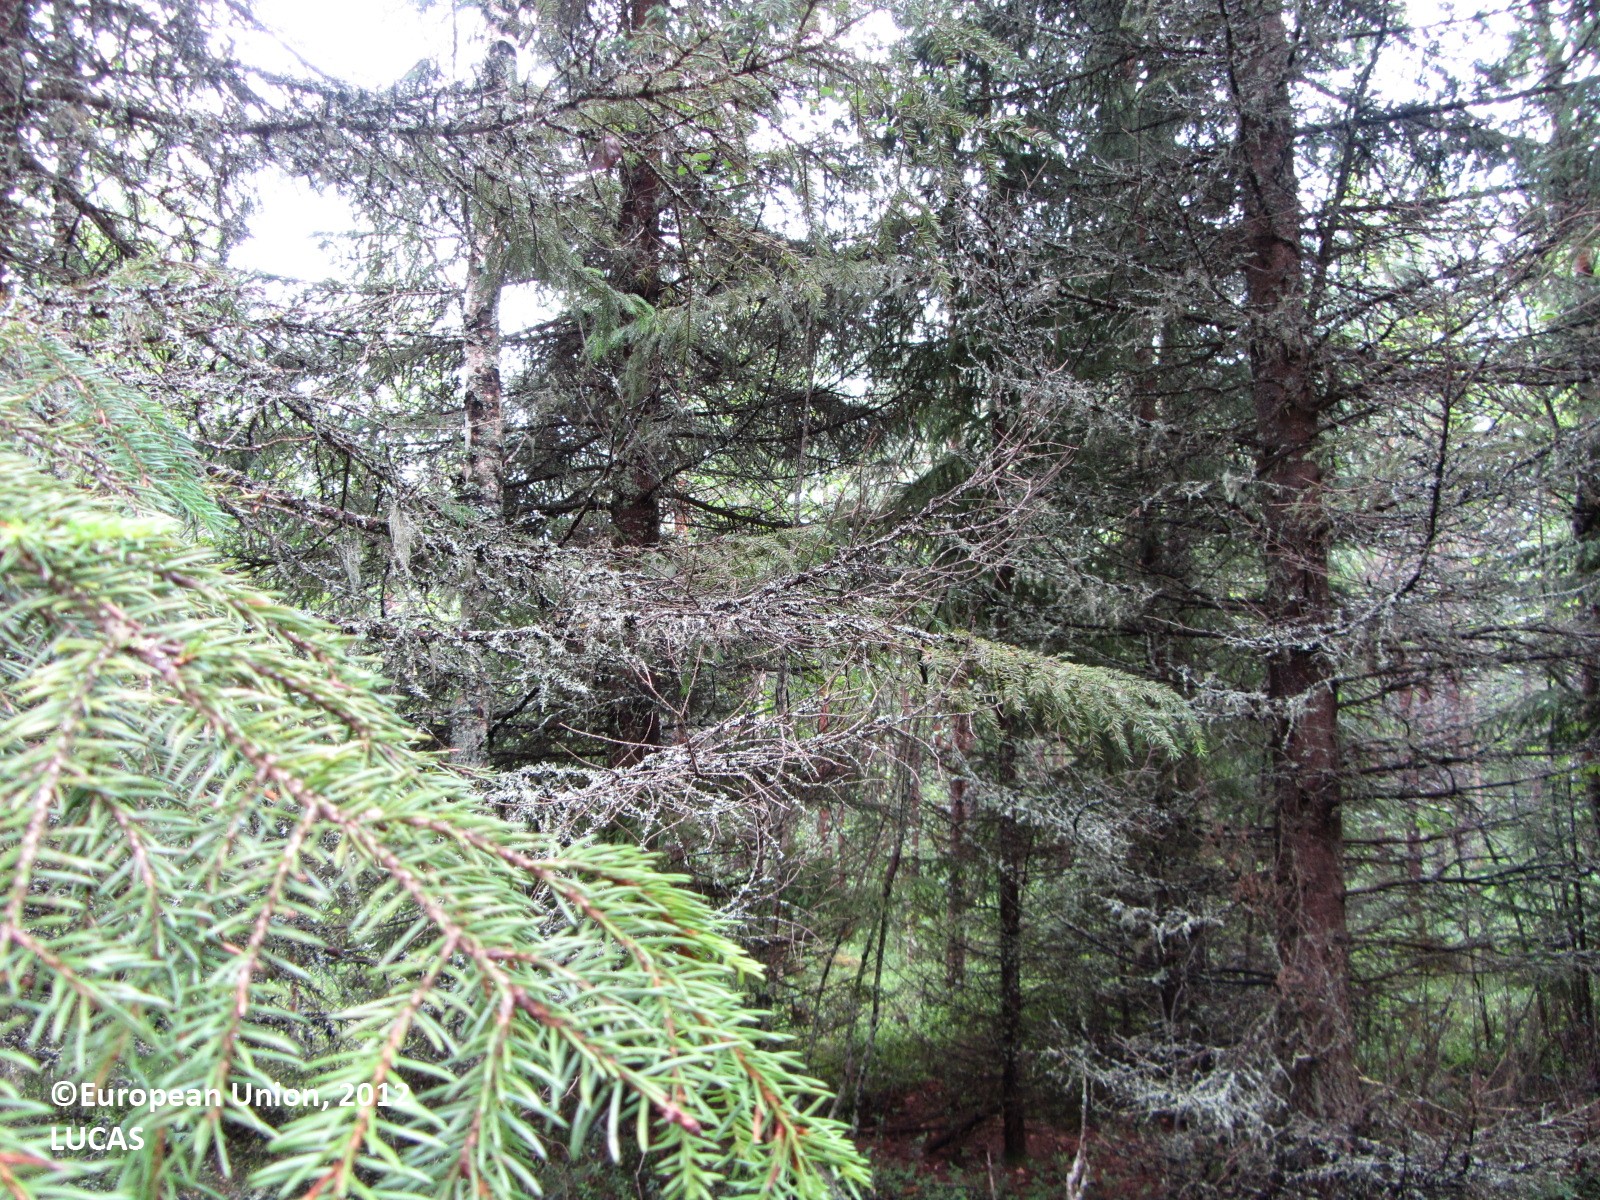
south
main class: Woodland
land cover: Spruce dominated coniferous woodland
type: boreal forest
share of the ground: > 75 %
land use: Forestry
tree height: > 5 m
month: July
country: FI
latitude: 63.8227
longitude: 25.6023
